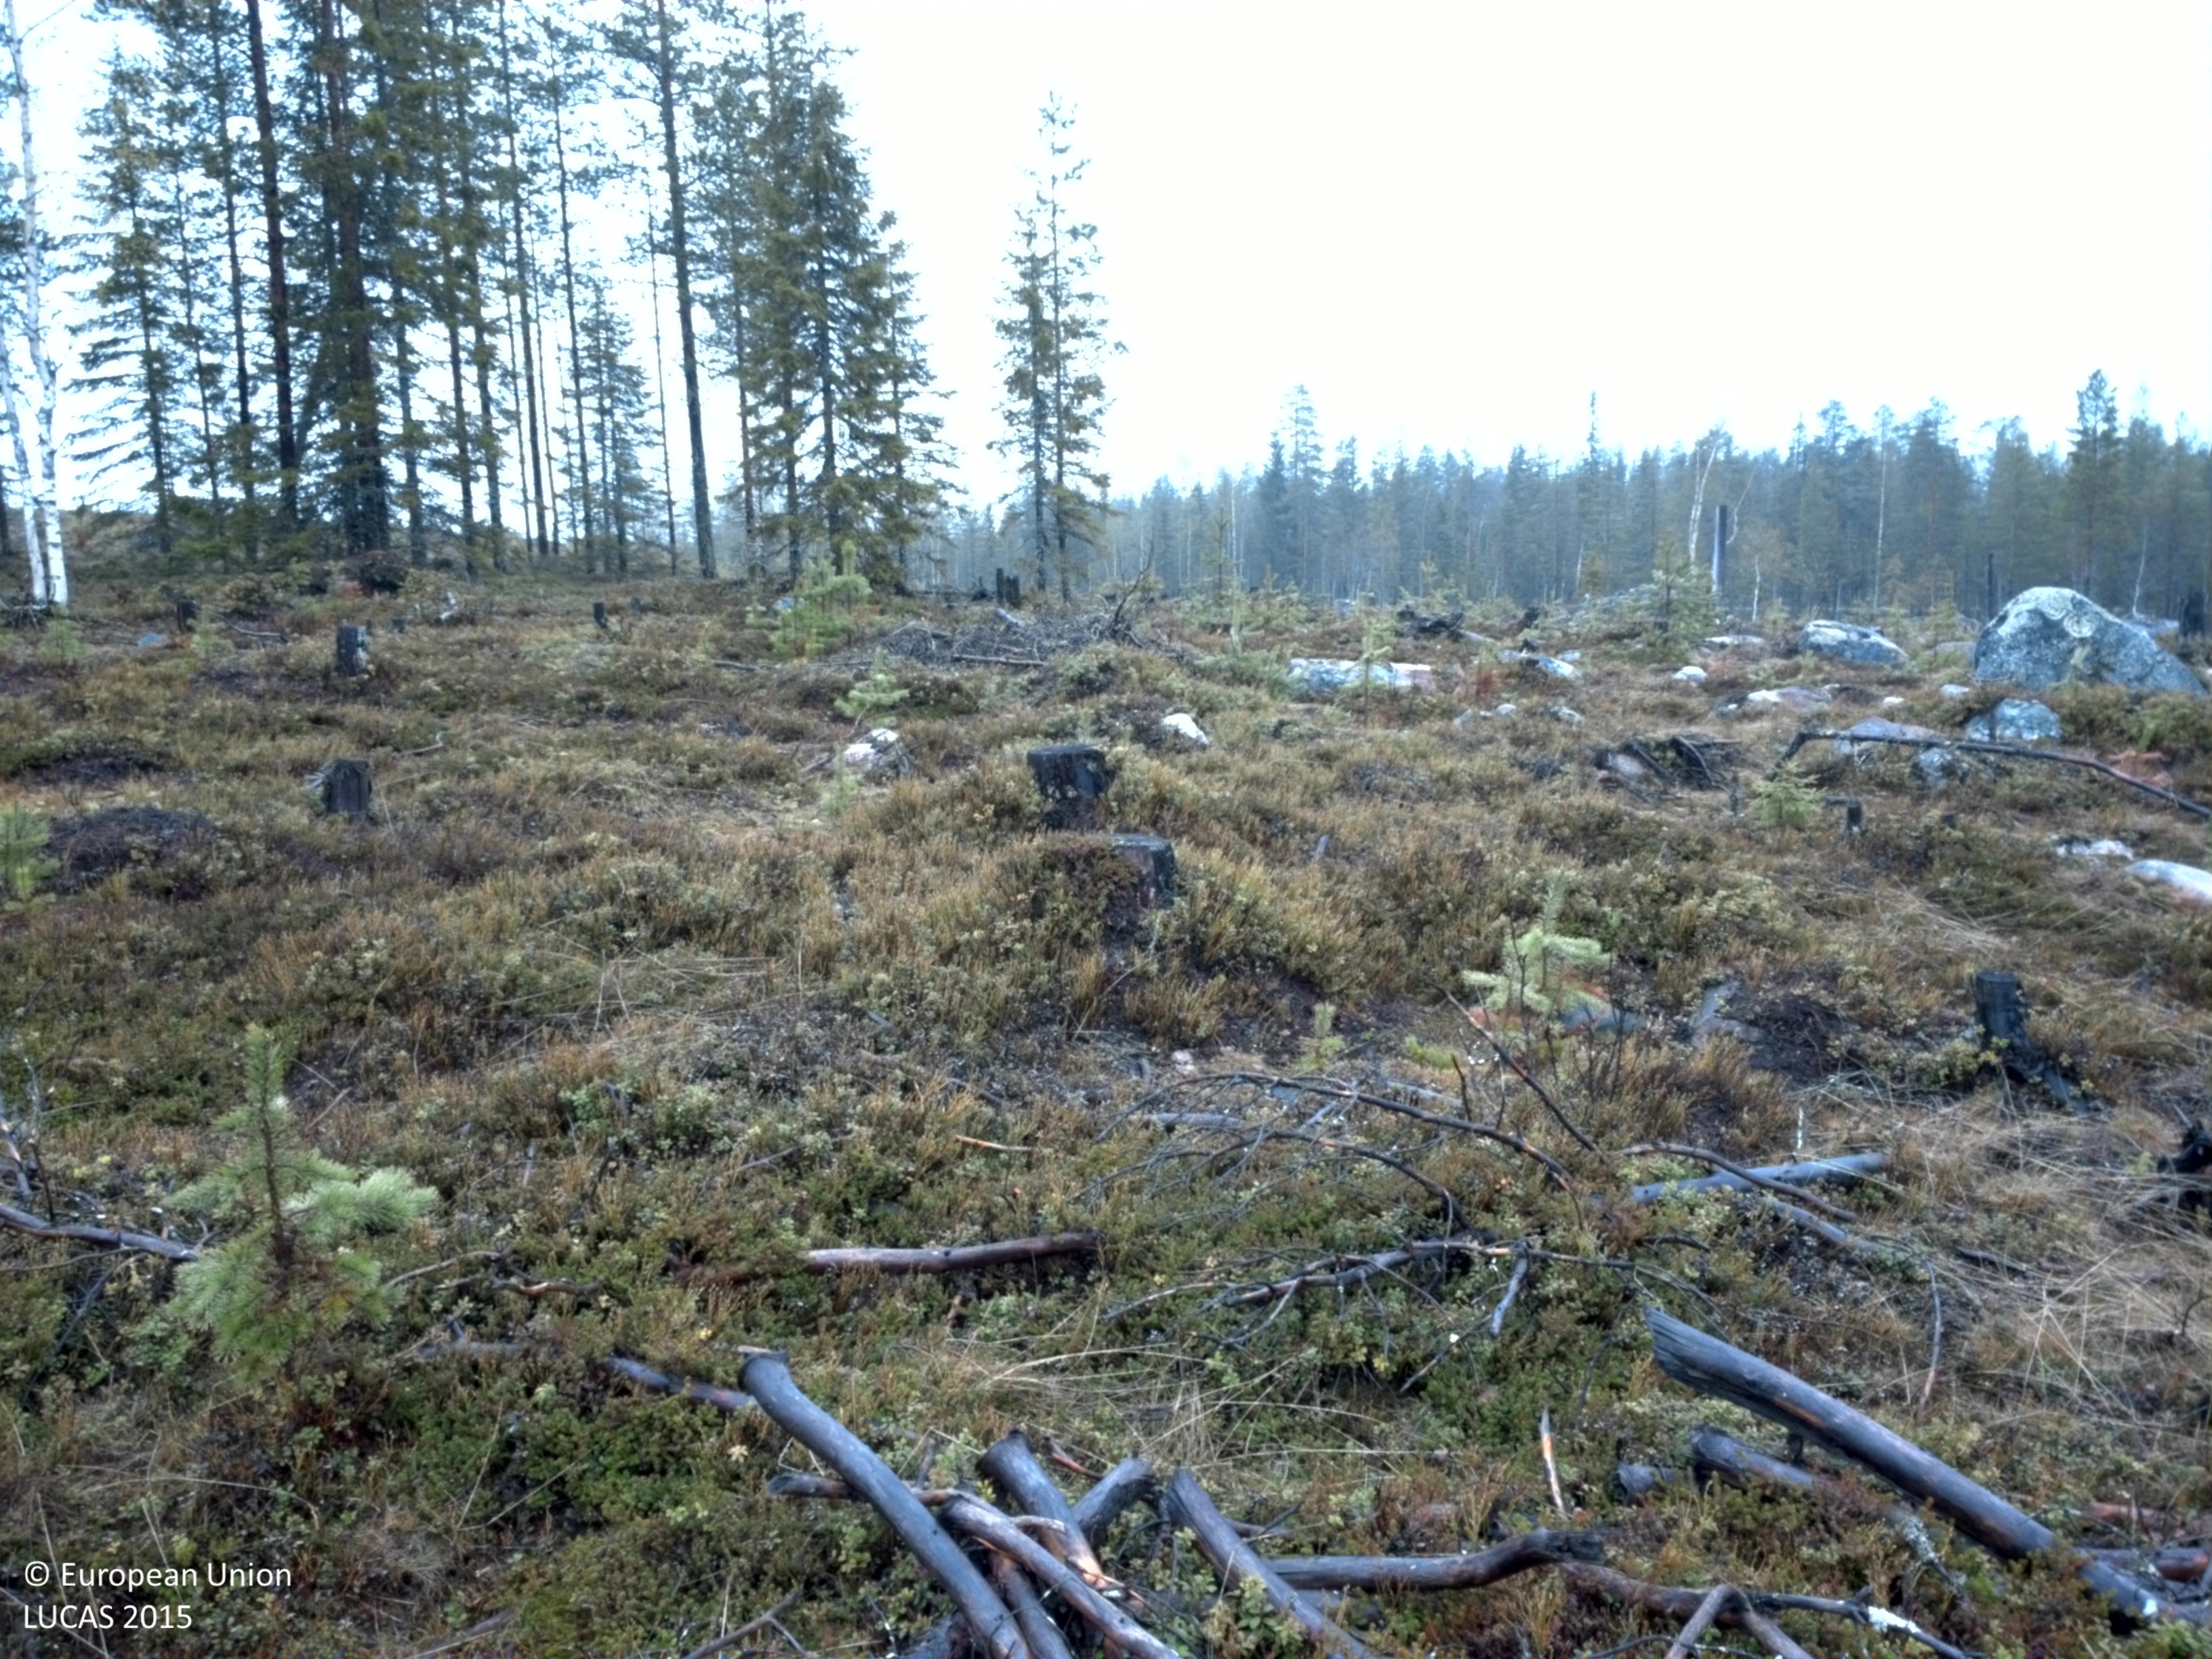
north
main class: Shrubland
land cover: Shrubland with sparse tree cover
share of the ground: > 75 %
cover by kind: shrubs 95 %, coniferous forest trees 5 %
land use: Forestry
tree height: < 5 m
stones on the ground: 10 - 25 %
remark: Clear cut
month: May
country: SE
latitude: 66.2859
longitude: 23.2418
